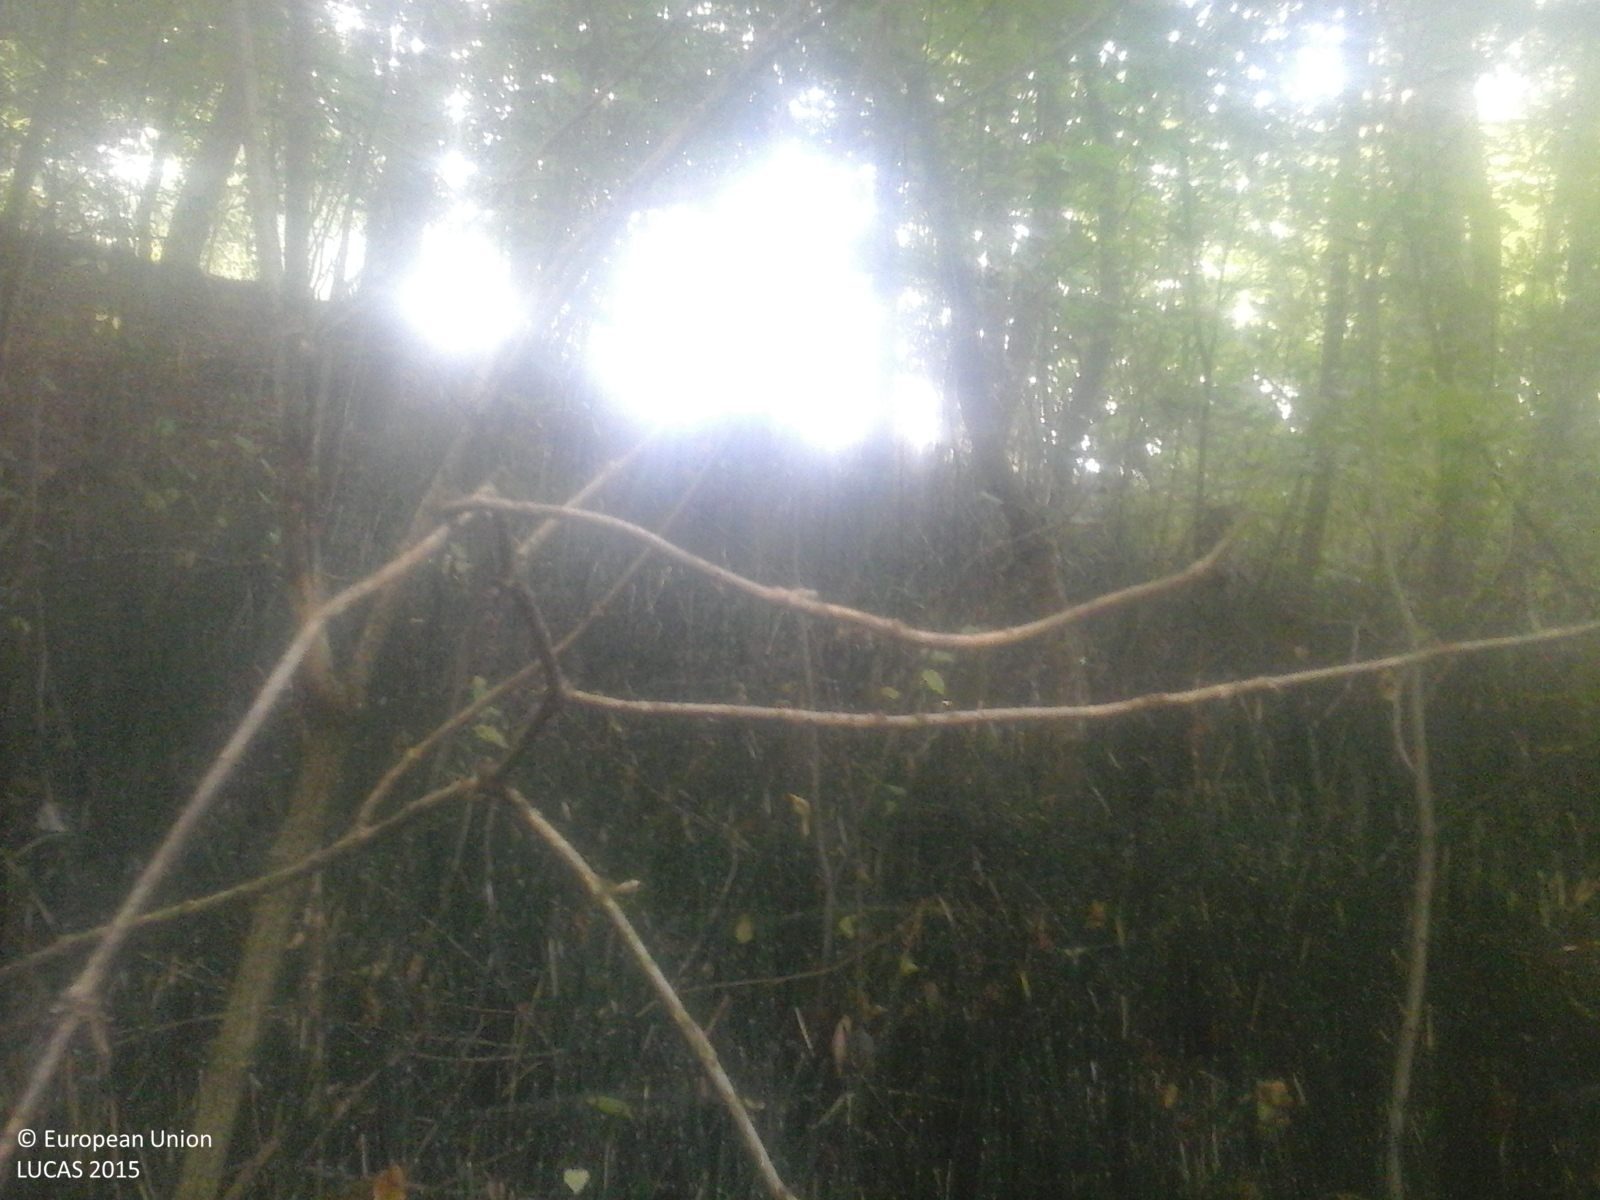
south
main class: Woodland
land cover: Broadleaved woodland
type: beech forest
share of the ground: > 75 %
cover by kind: broadleaved forest trees 100 %
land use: Forestry
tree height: > 5 m
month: September
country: RO
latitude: 46.0689
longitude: 22.8141
